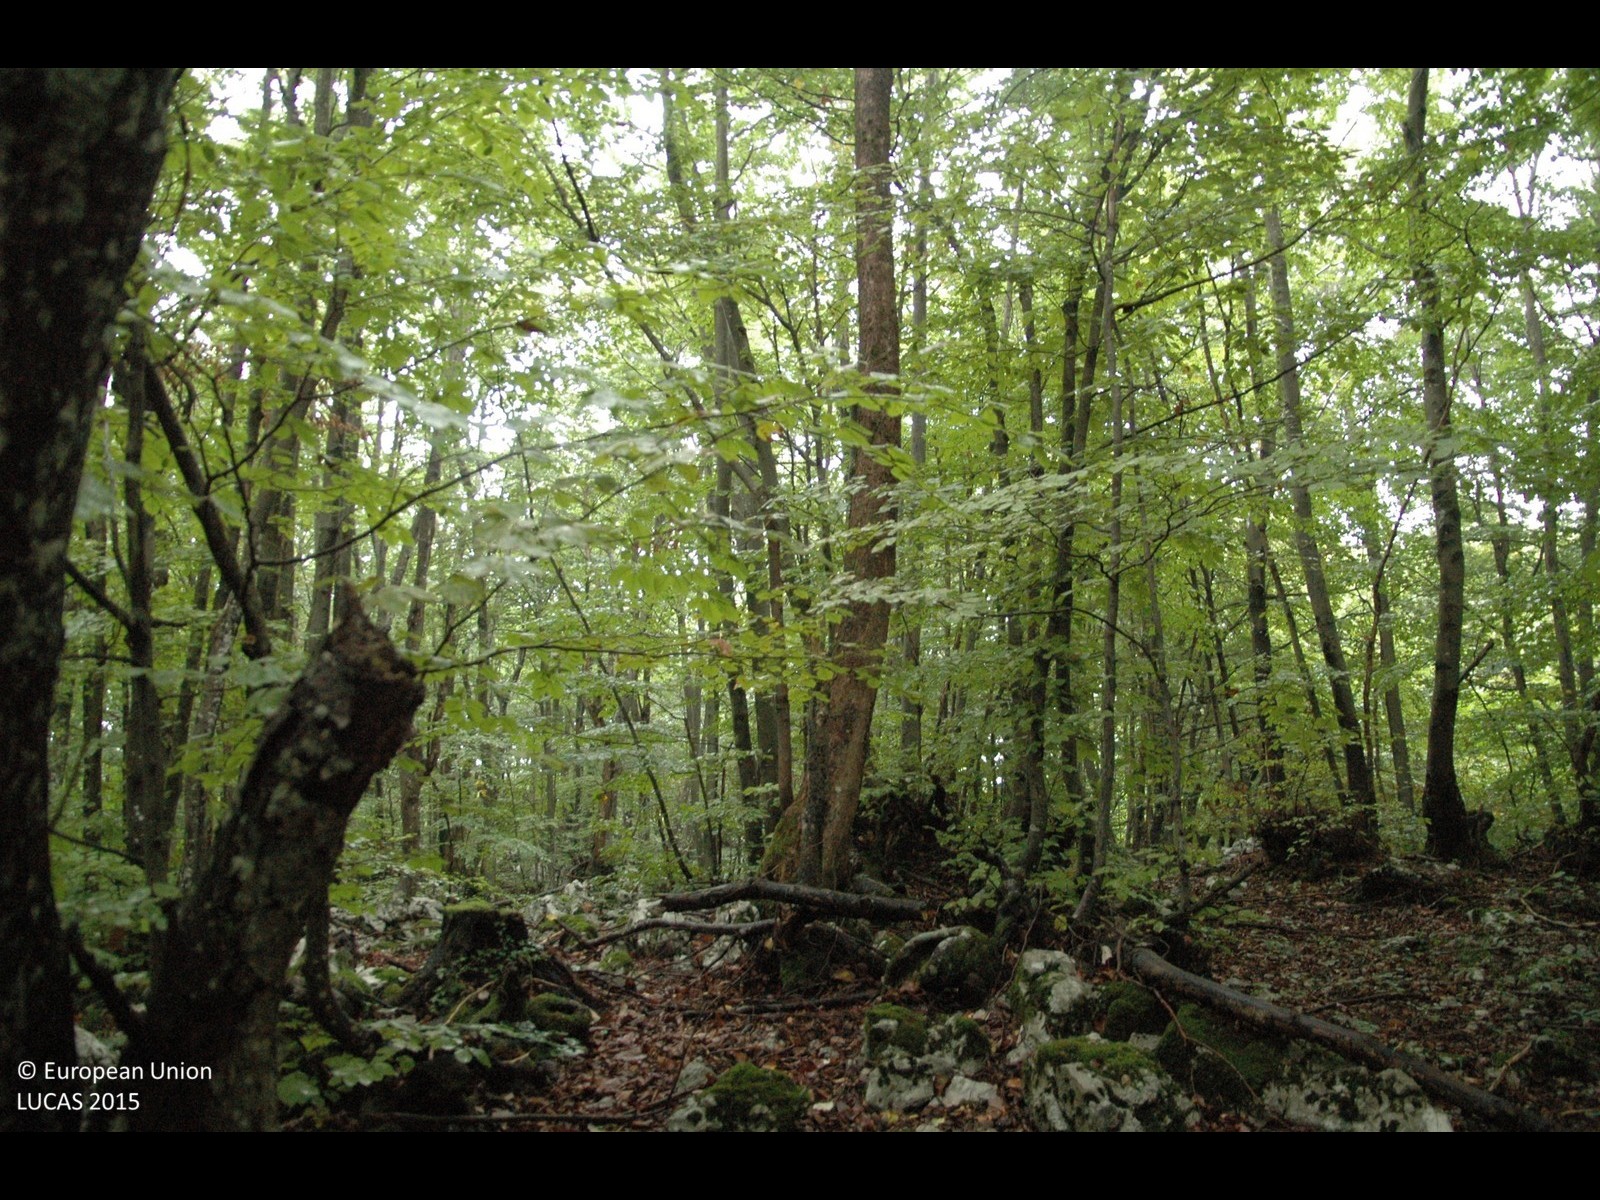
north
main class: Woodland
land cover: Broadleaved woodland
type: beech forest
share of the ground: > 75 %
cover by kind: broadleaved forest trees 100 %
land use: Forestry
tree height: > 5 m
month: October
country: HR
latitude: 45.1392
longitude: 15.2469
